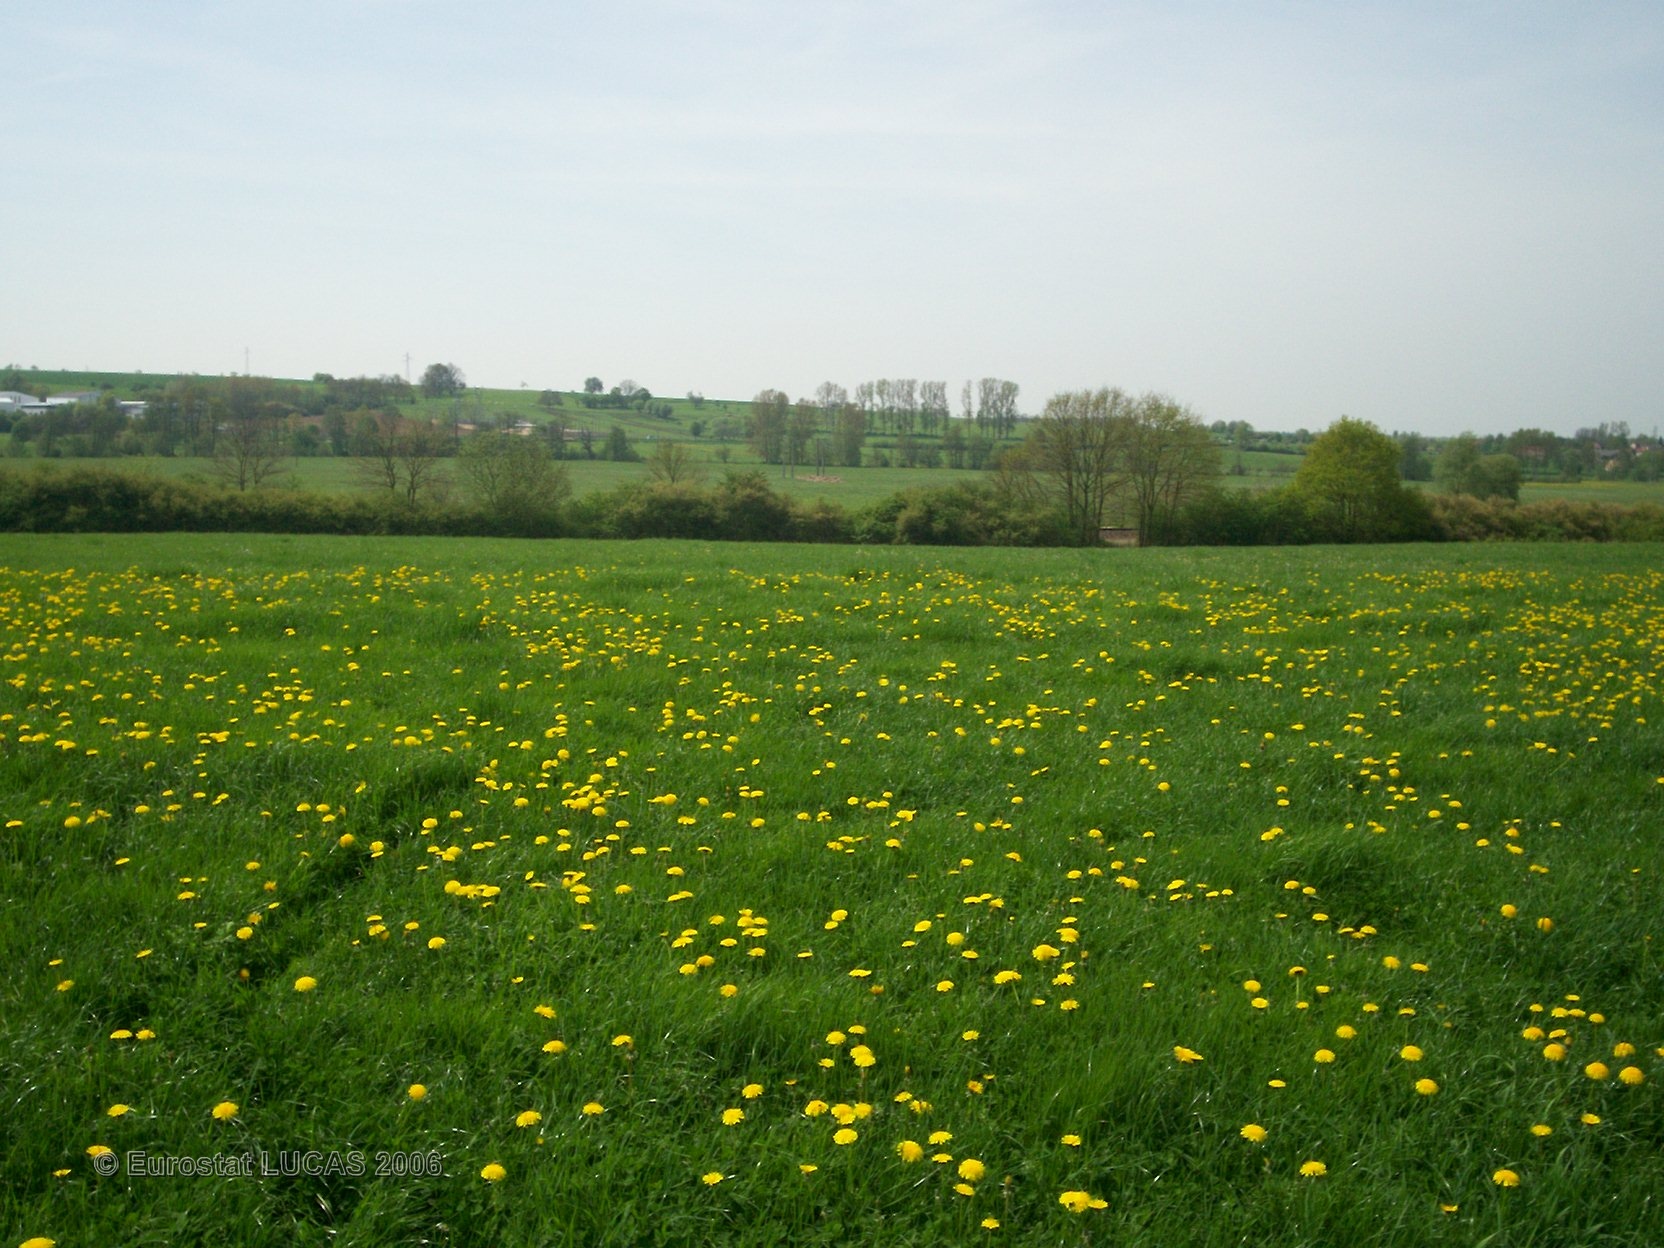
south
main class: Grassland
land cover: Grassland without tree/shrub cover
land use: Agriculture (excluding fallow land and kitchen gardens)
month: May
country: FR
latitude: 48.9407
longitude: 7.0652
